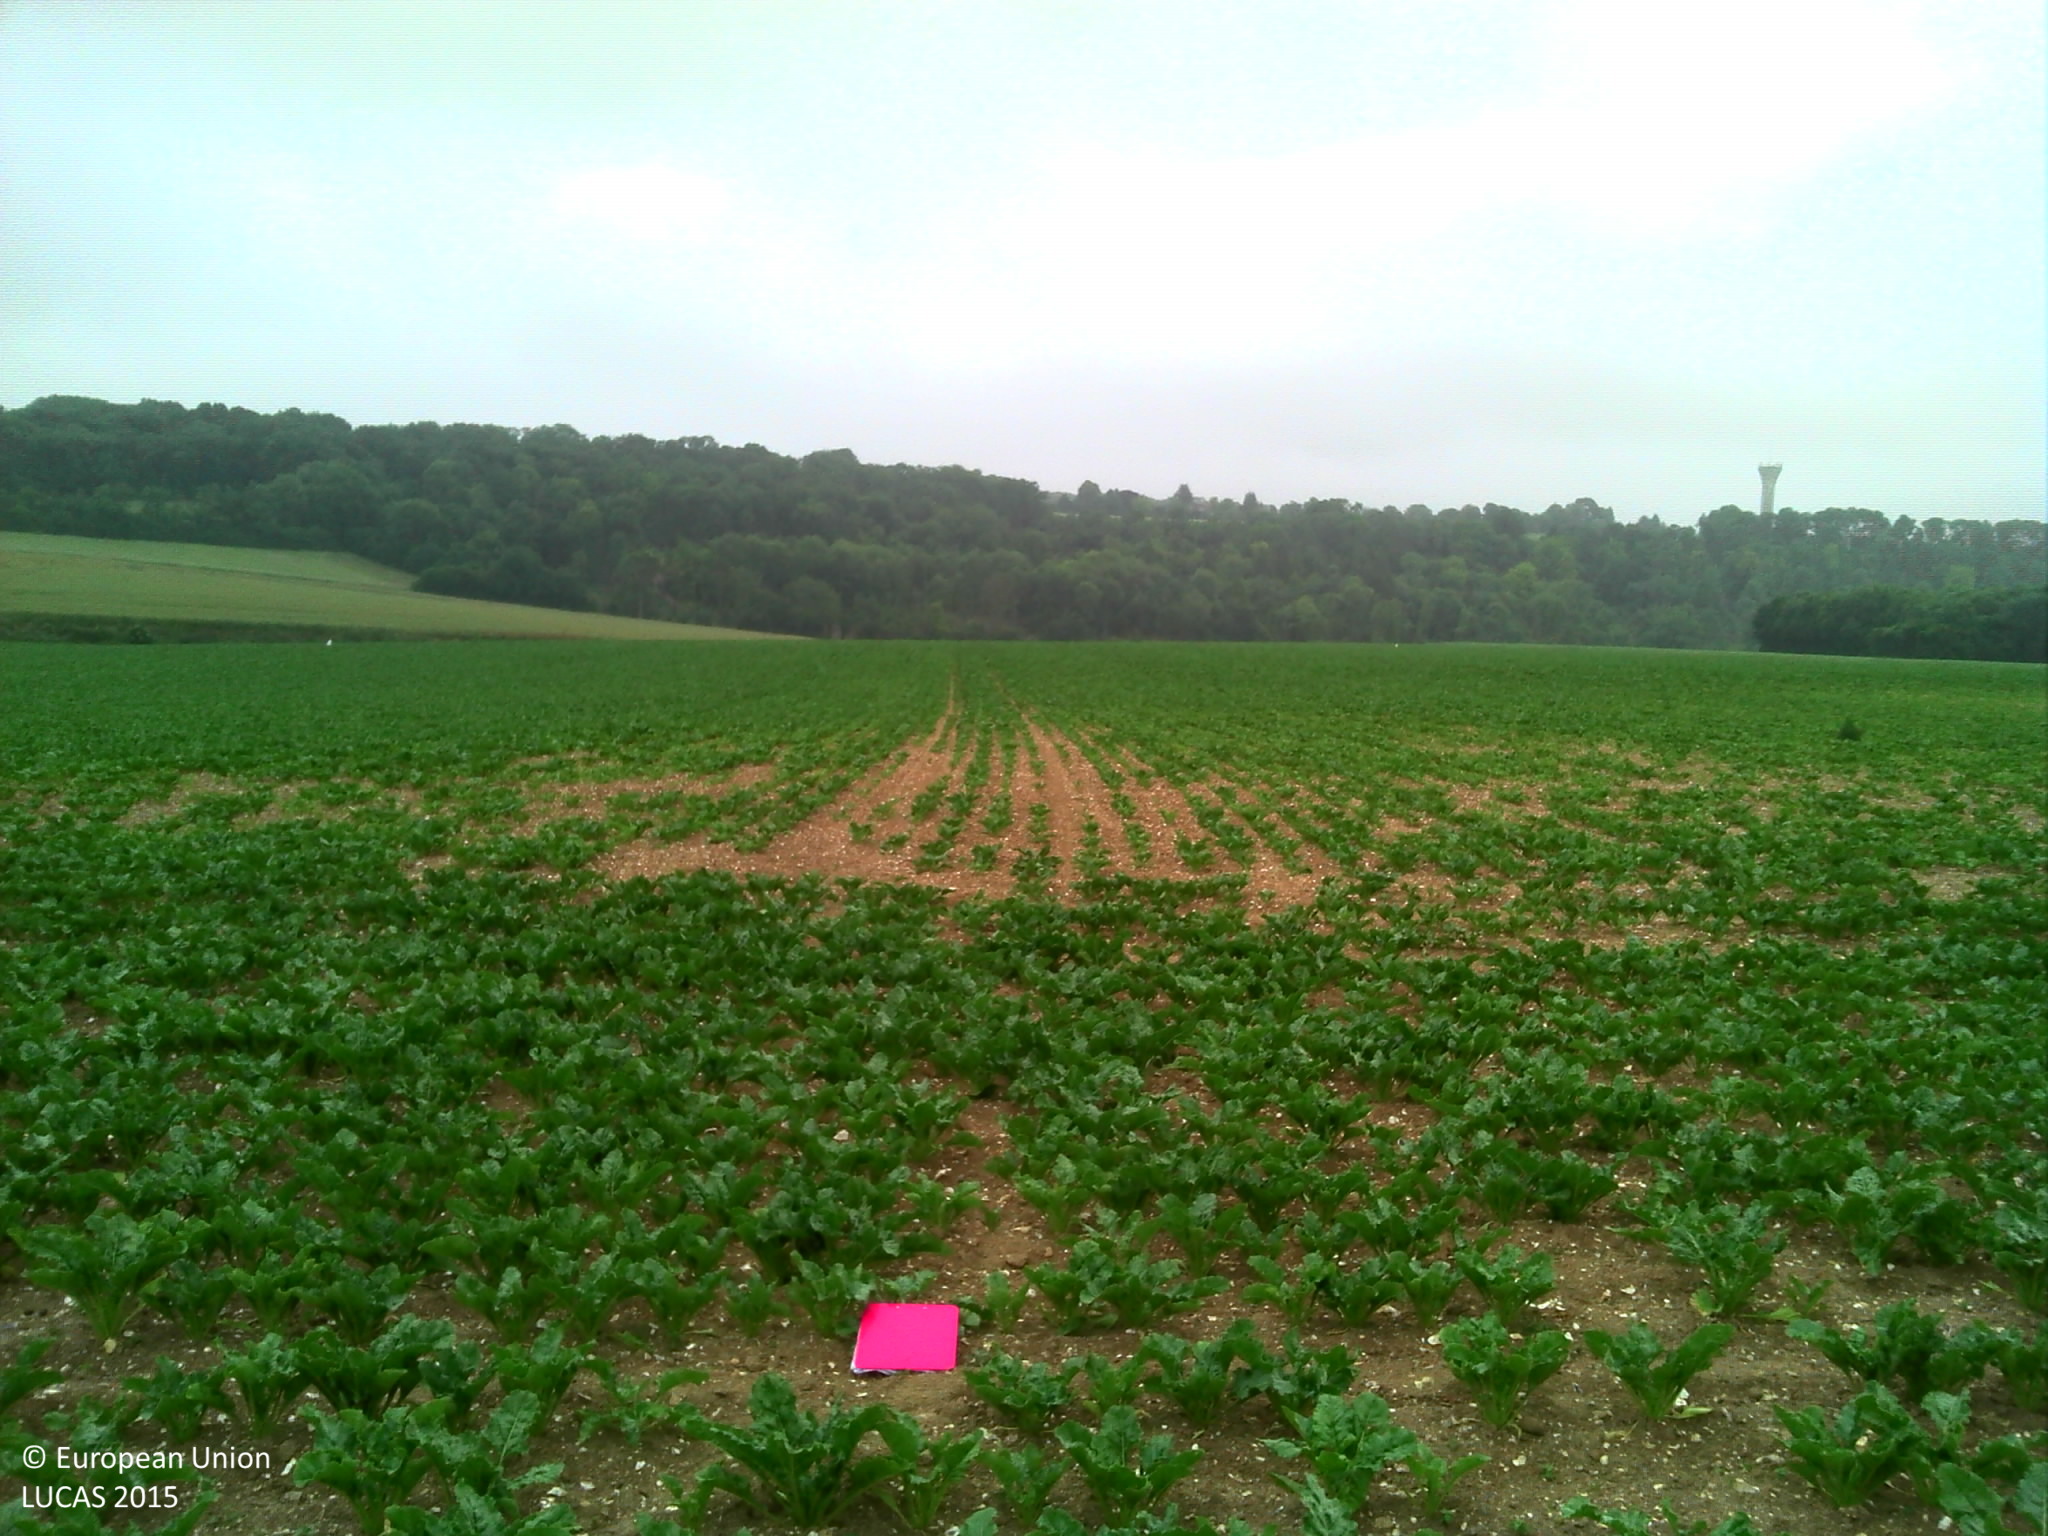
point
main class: Cropland
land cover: Sugar beet
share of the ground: 50 - 75 %
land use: Agriculture (excluding fallow land and kitchen gardens)
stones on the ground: < 10 %
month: June
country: FR
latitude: 49.4635
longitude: 2.4404
